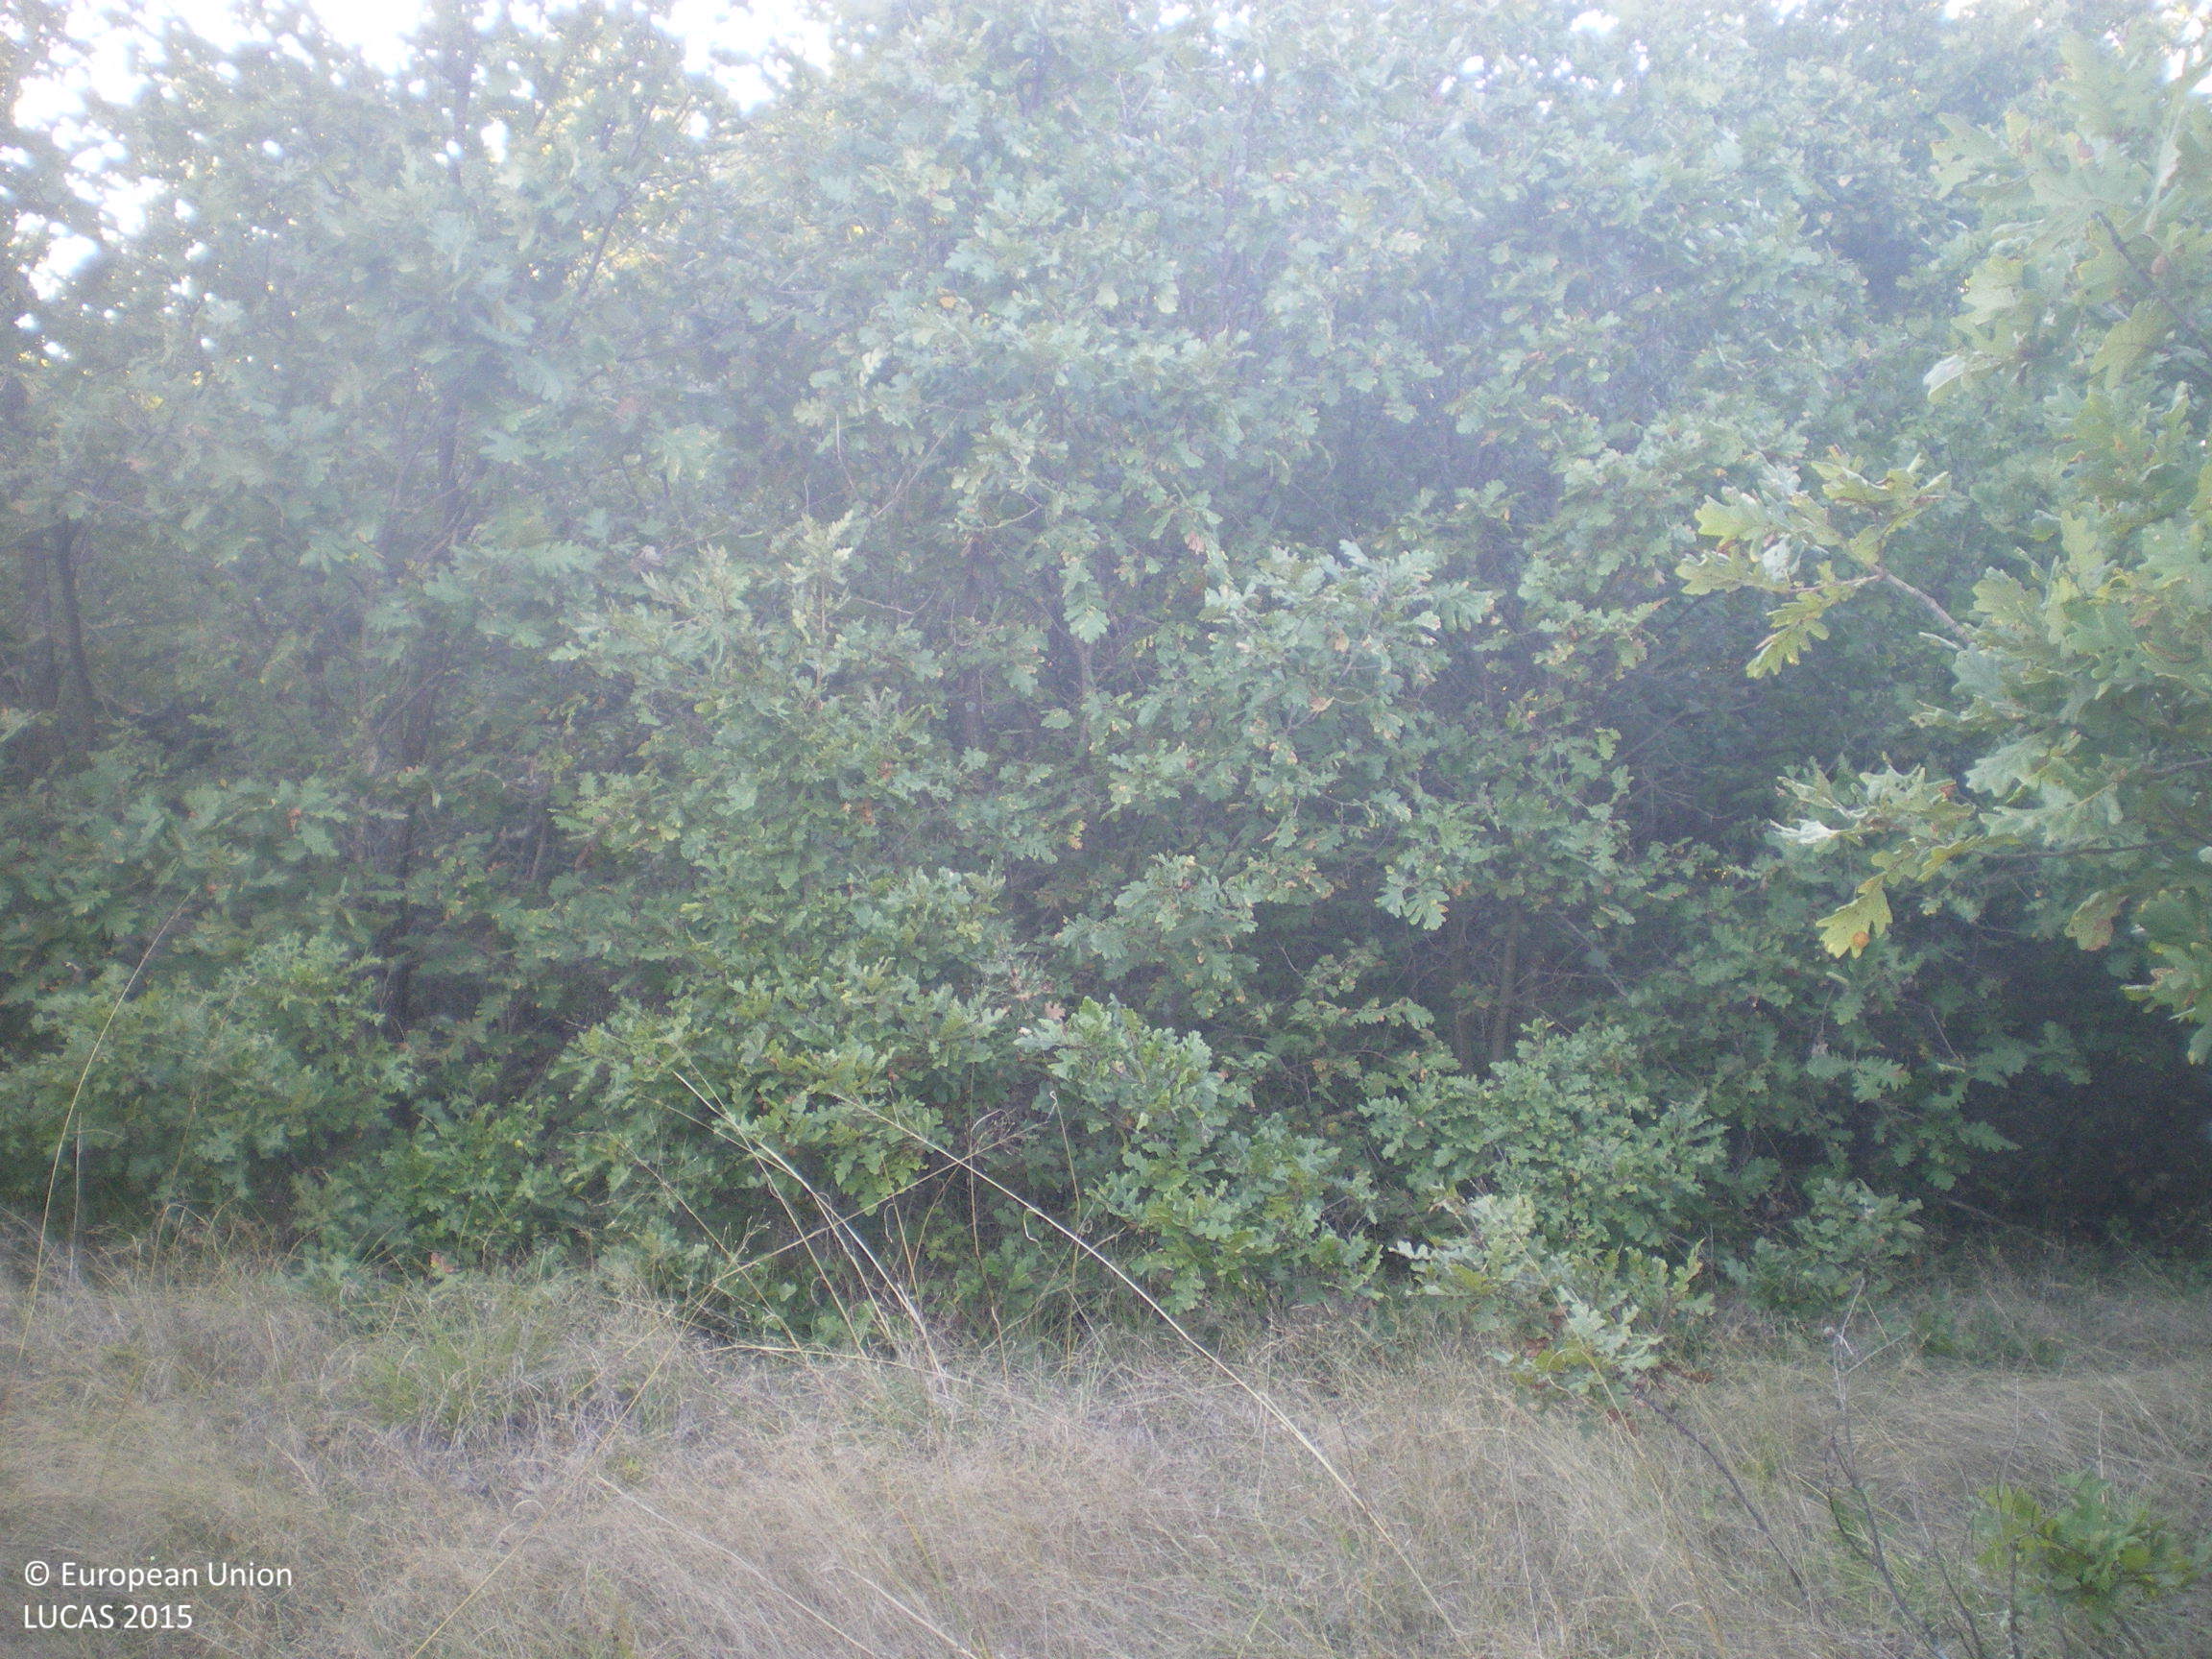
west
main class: Woodland
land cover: Broadleaved woodland
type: mesophytic deciduous forest
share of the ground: 50 - 75 %
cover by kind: broadleaved forest trees 75 %, herbaceous plants 20 %, shrubs 5 %
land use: Forestry
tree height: > 5 m
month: September
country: BG
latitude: 41.8529
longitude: 25.9837
